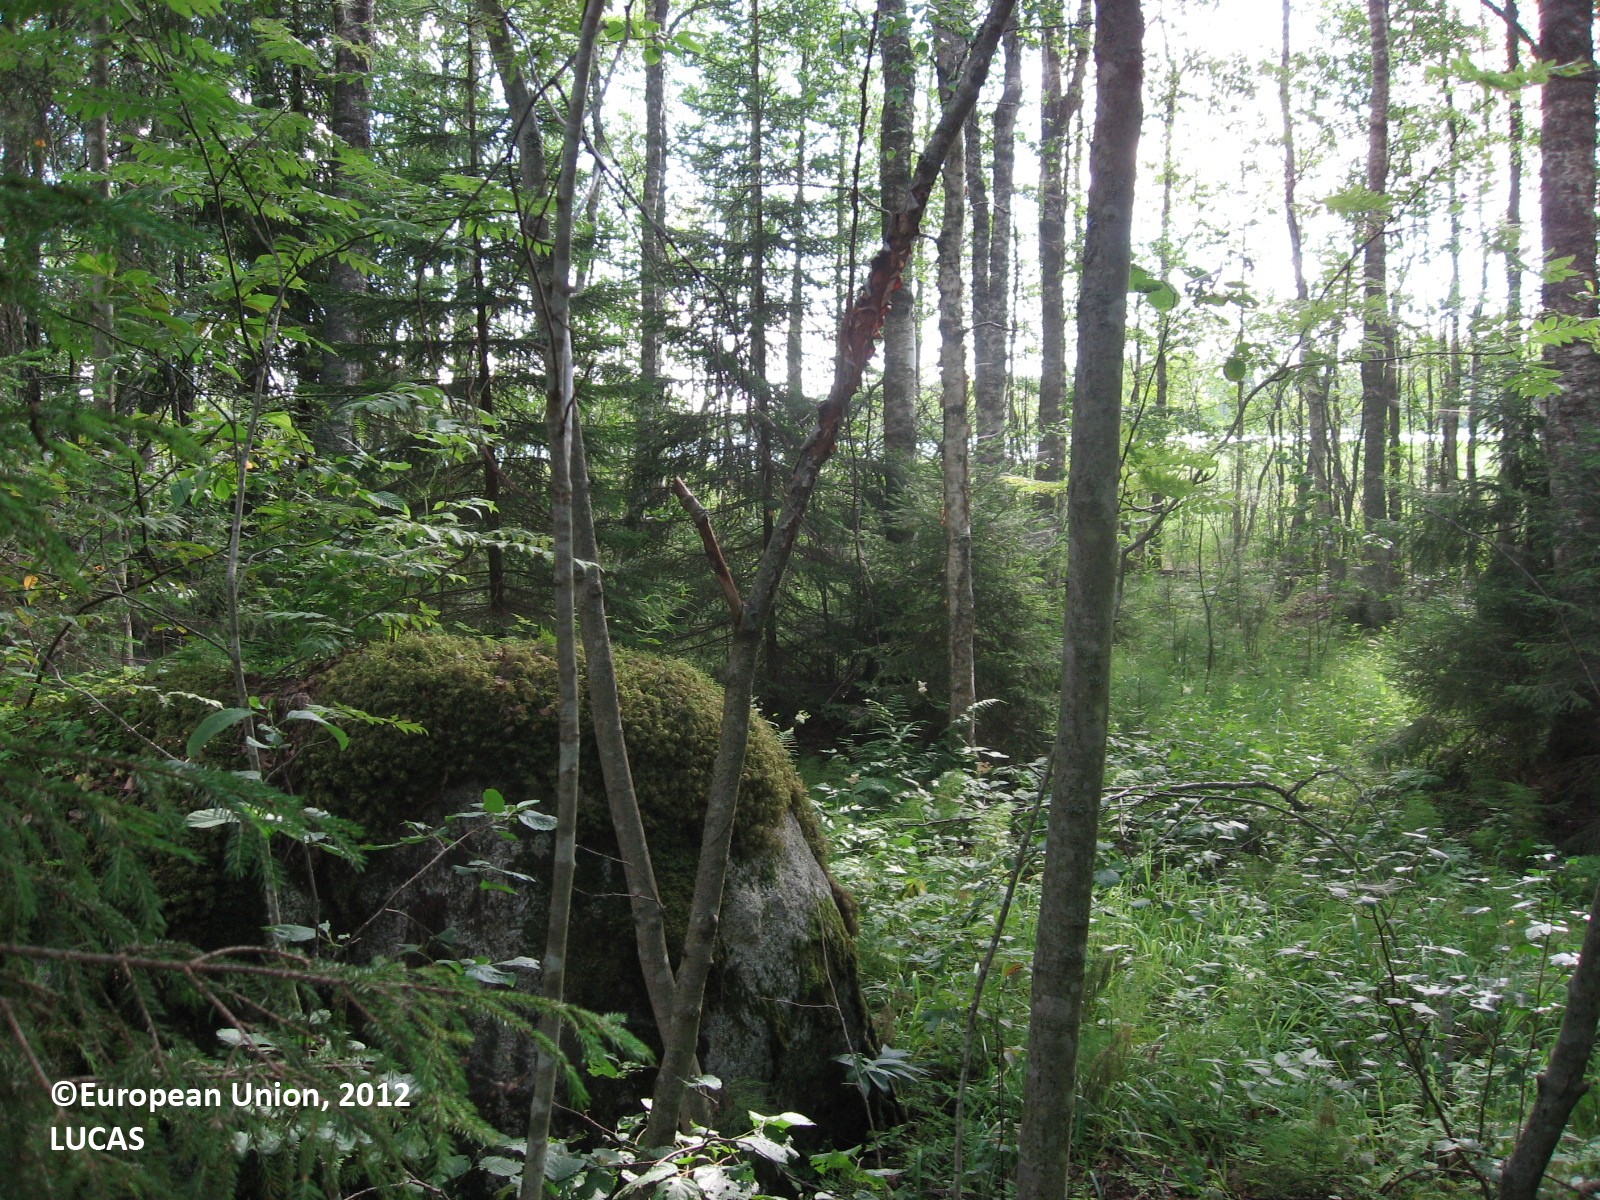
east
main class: Woodland
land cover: Spruce dominated mixed woodland
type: boreal forest
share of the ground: 50 - 75 %
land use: Forestry
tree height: > 5 m
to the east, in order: Spruce dominated mixed woodland; Broadleaved woodland; Inland marshes; Inland water bodies
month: July
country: FI
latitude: 61.2611
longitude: 25.3899
